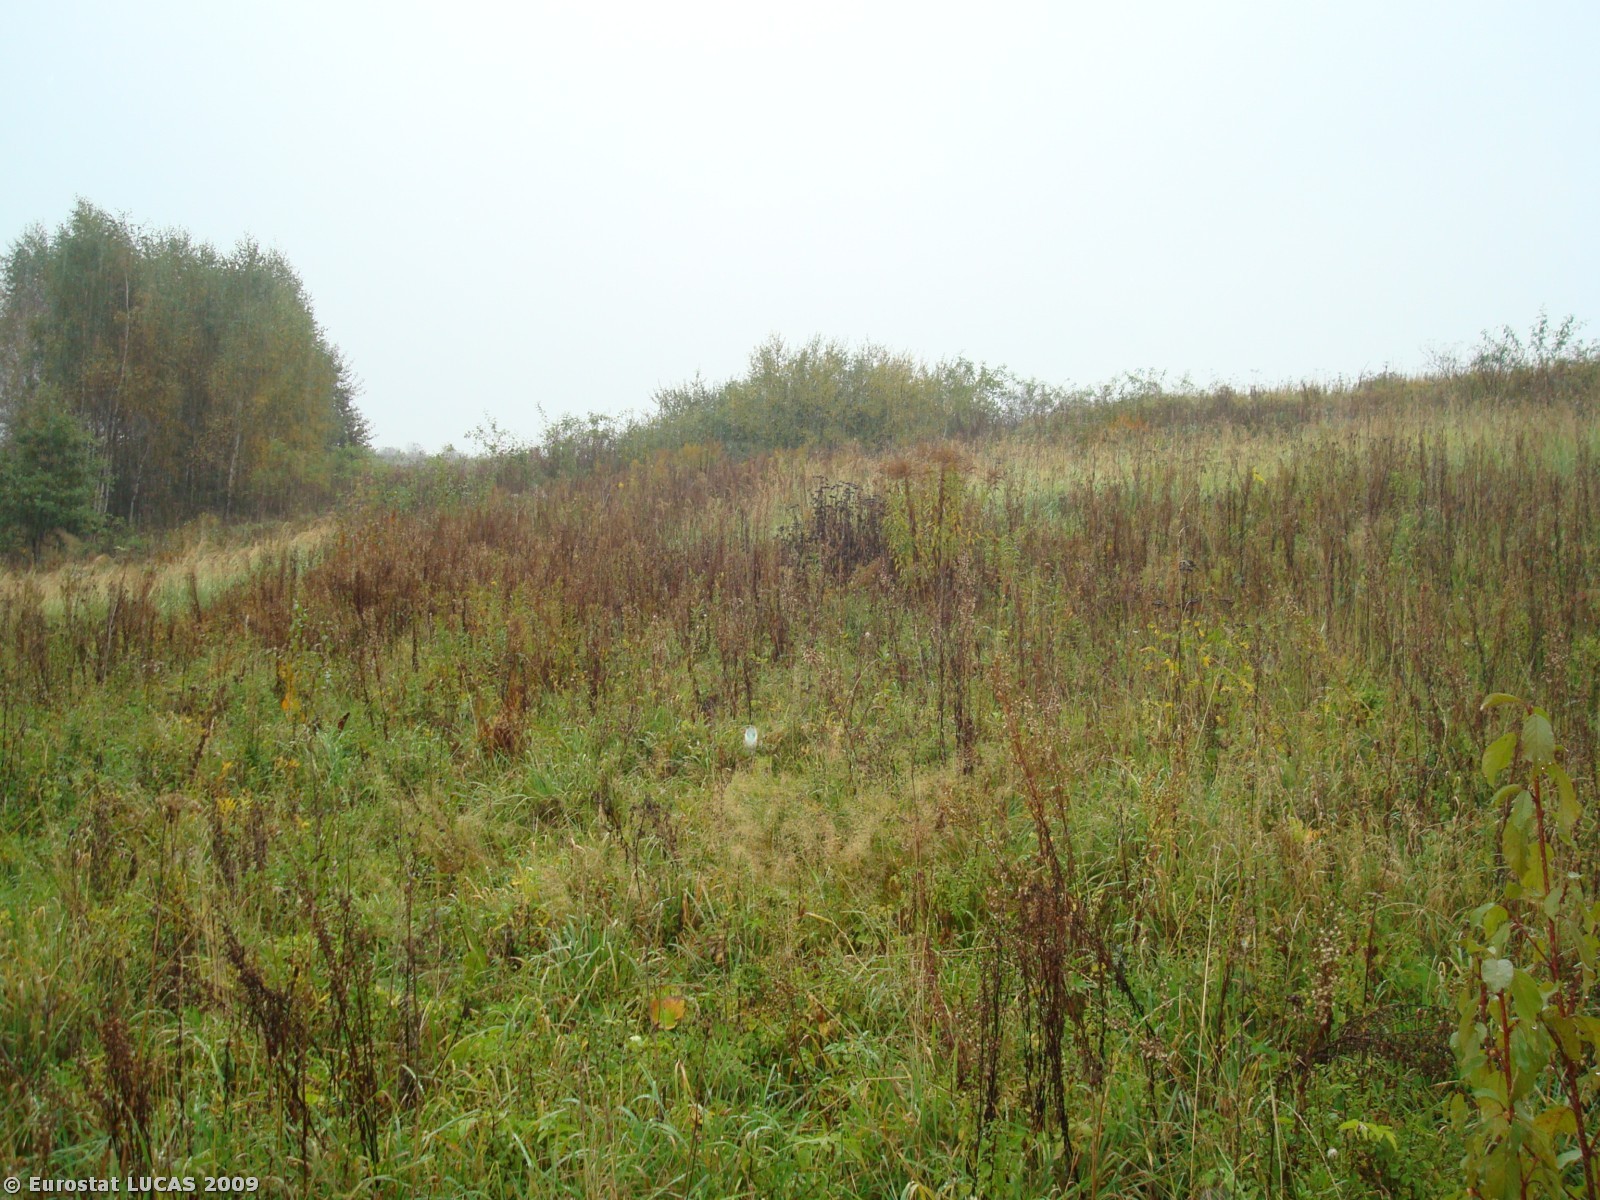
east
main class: Grassland
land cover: Spontaneously vegetated surfaces
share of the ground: > 75 %
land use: Unused
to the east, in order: Spontaneously vegetated surfaces; Grassland without tree/shrub cover; Broadleaved woodland; Triticale; Grass margins; Oats; Grass margins; Common wheat
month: September
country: PL
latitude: 49.8320
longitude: 19.6069
